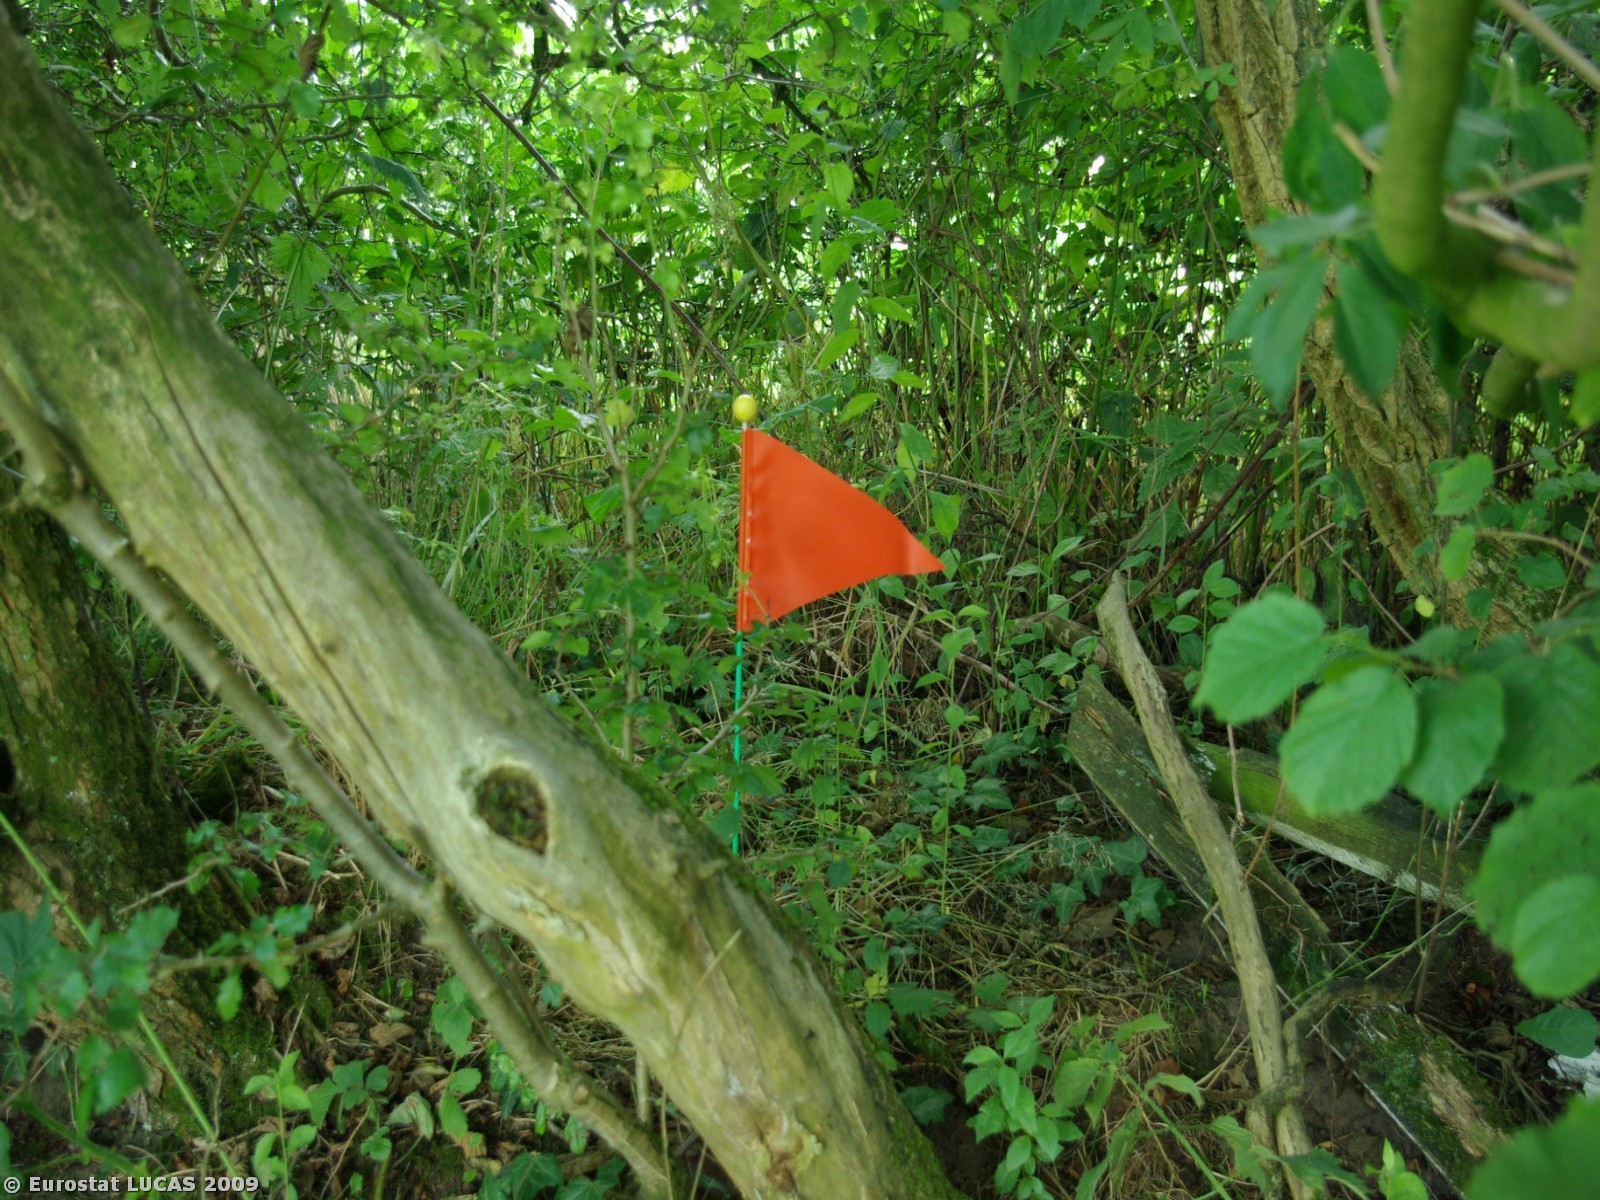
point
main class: Woodland
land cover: Mixed woodland
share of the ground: > 75 %
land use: Unused
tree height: > 5 m
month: July
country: DK
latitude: 54.9815
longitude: 9.2974
